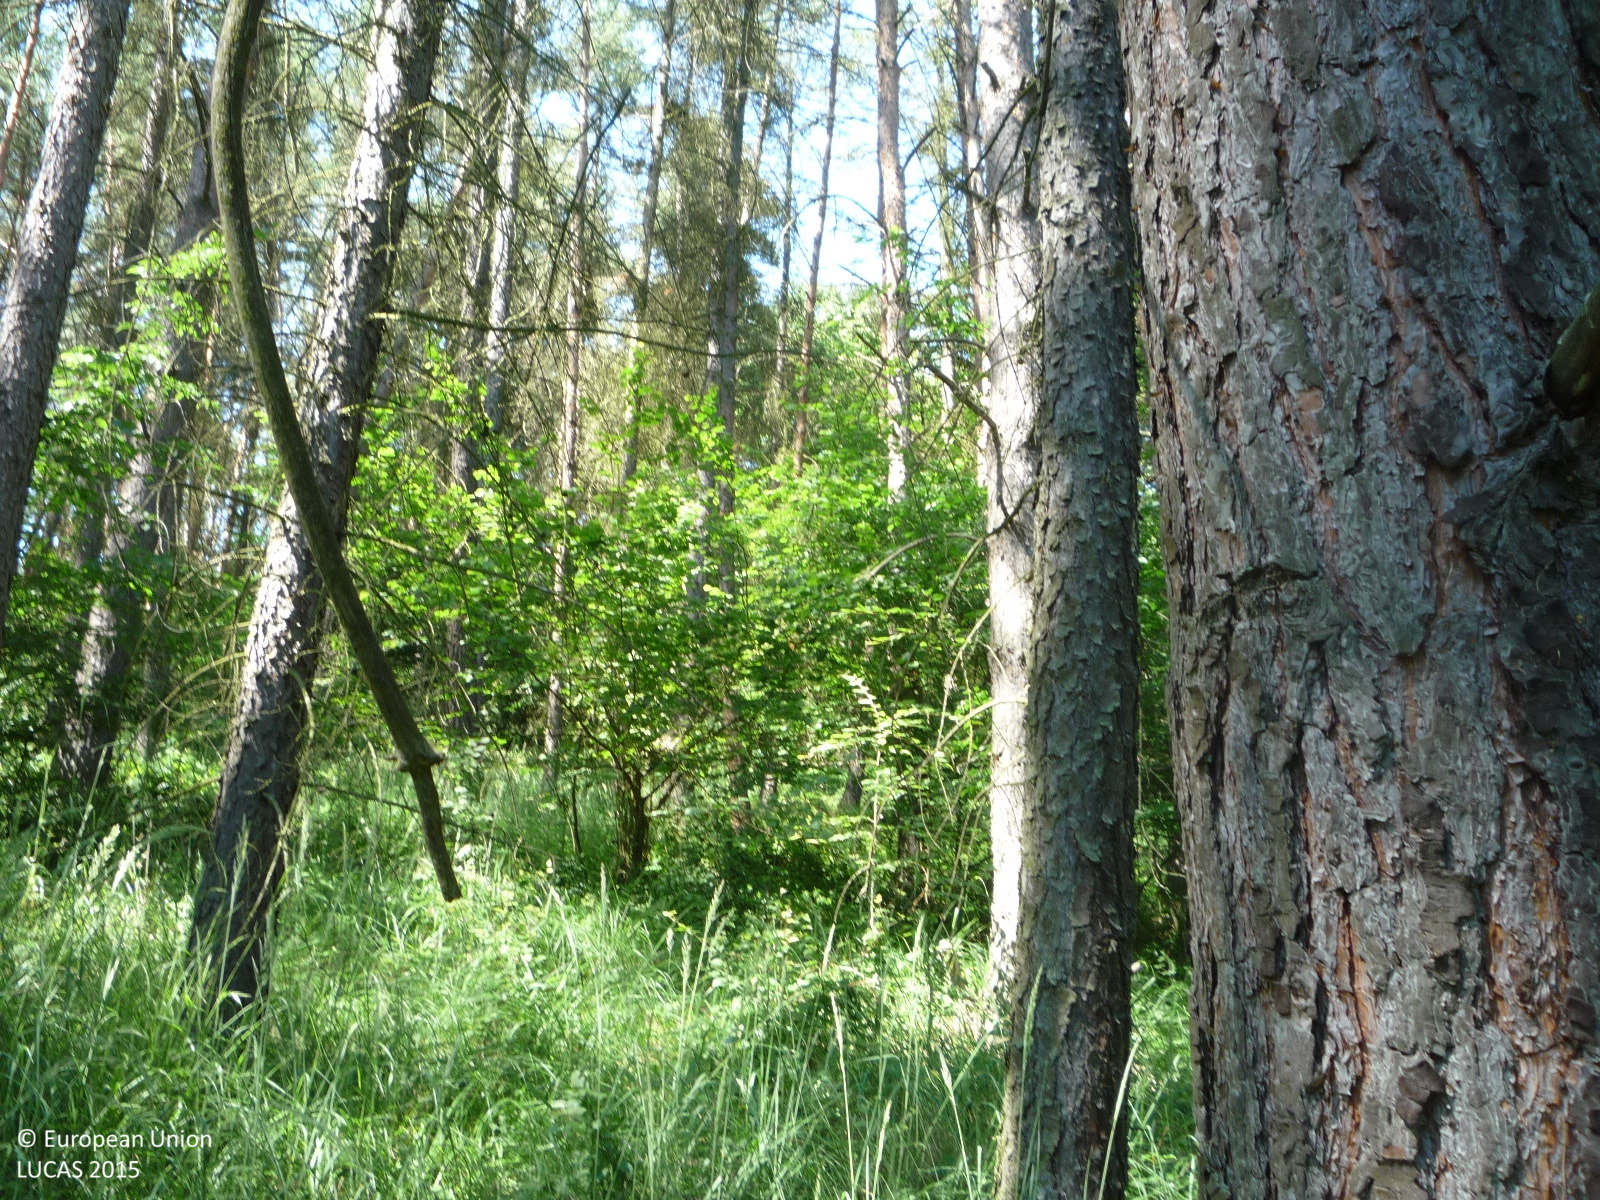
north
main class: Woodland
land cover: Other coniferous woodland
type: hemiboreal forest and nemoral coniferous forest and mixed broadleaved-coniferous forest
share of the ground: > 75 %
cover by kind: coniferous forest trees 90 %, broadleaved forest trees 5 %, herbaceous plants 5 %
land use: Forestry
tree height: > 5 m
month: July
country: CZ
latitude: 50.4727
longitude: 14.5248
